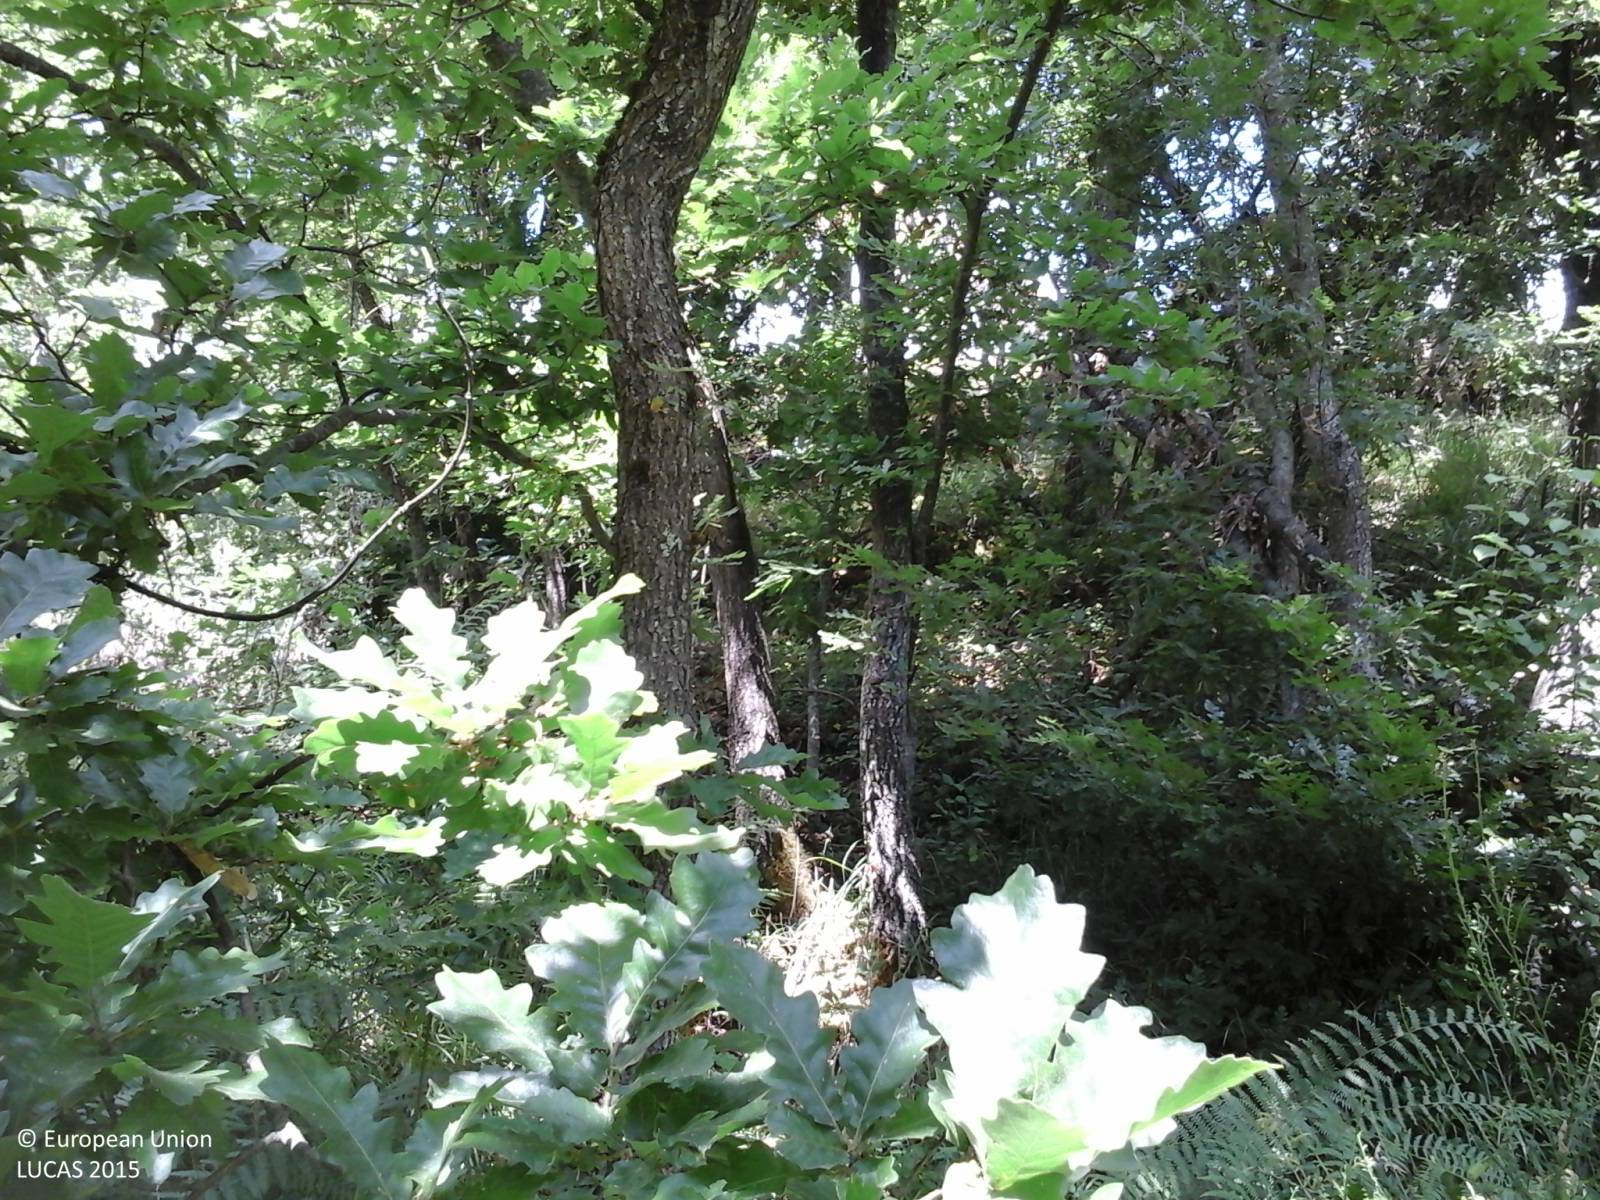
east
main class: Woodland
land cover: Broadleaved woodland
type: thermophilous deciduous forest
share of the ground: > 75 %
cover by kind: broadleaved forest trees 100 %
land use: Forestry
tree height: > 5 m
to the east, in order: Broadleaved woodland; Grassland without tree/shrub cover; Broadleaved woodland
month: June
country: IT
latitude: 44.1878
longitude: 10.2871
